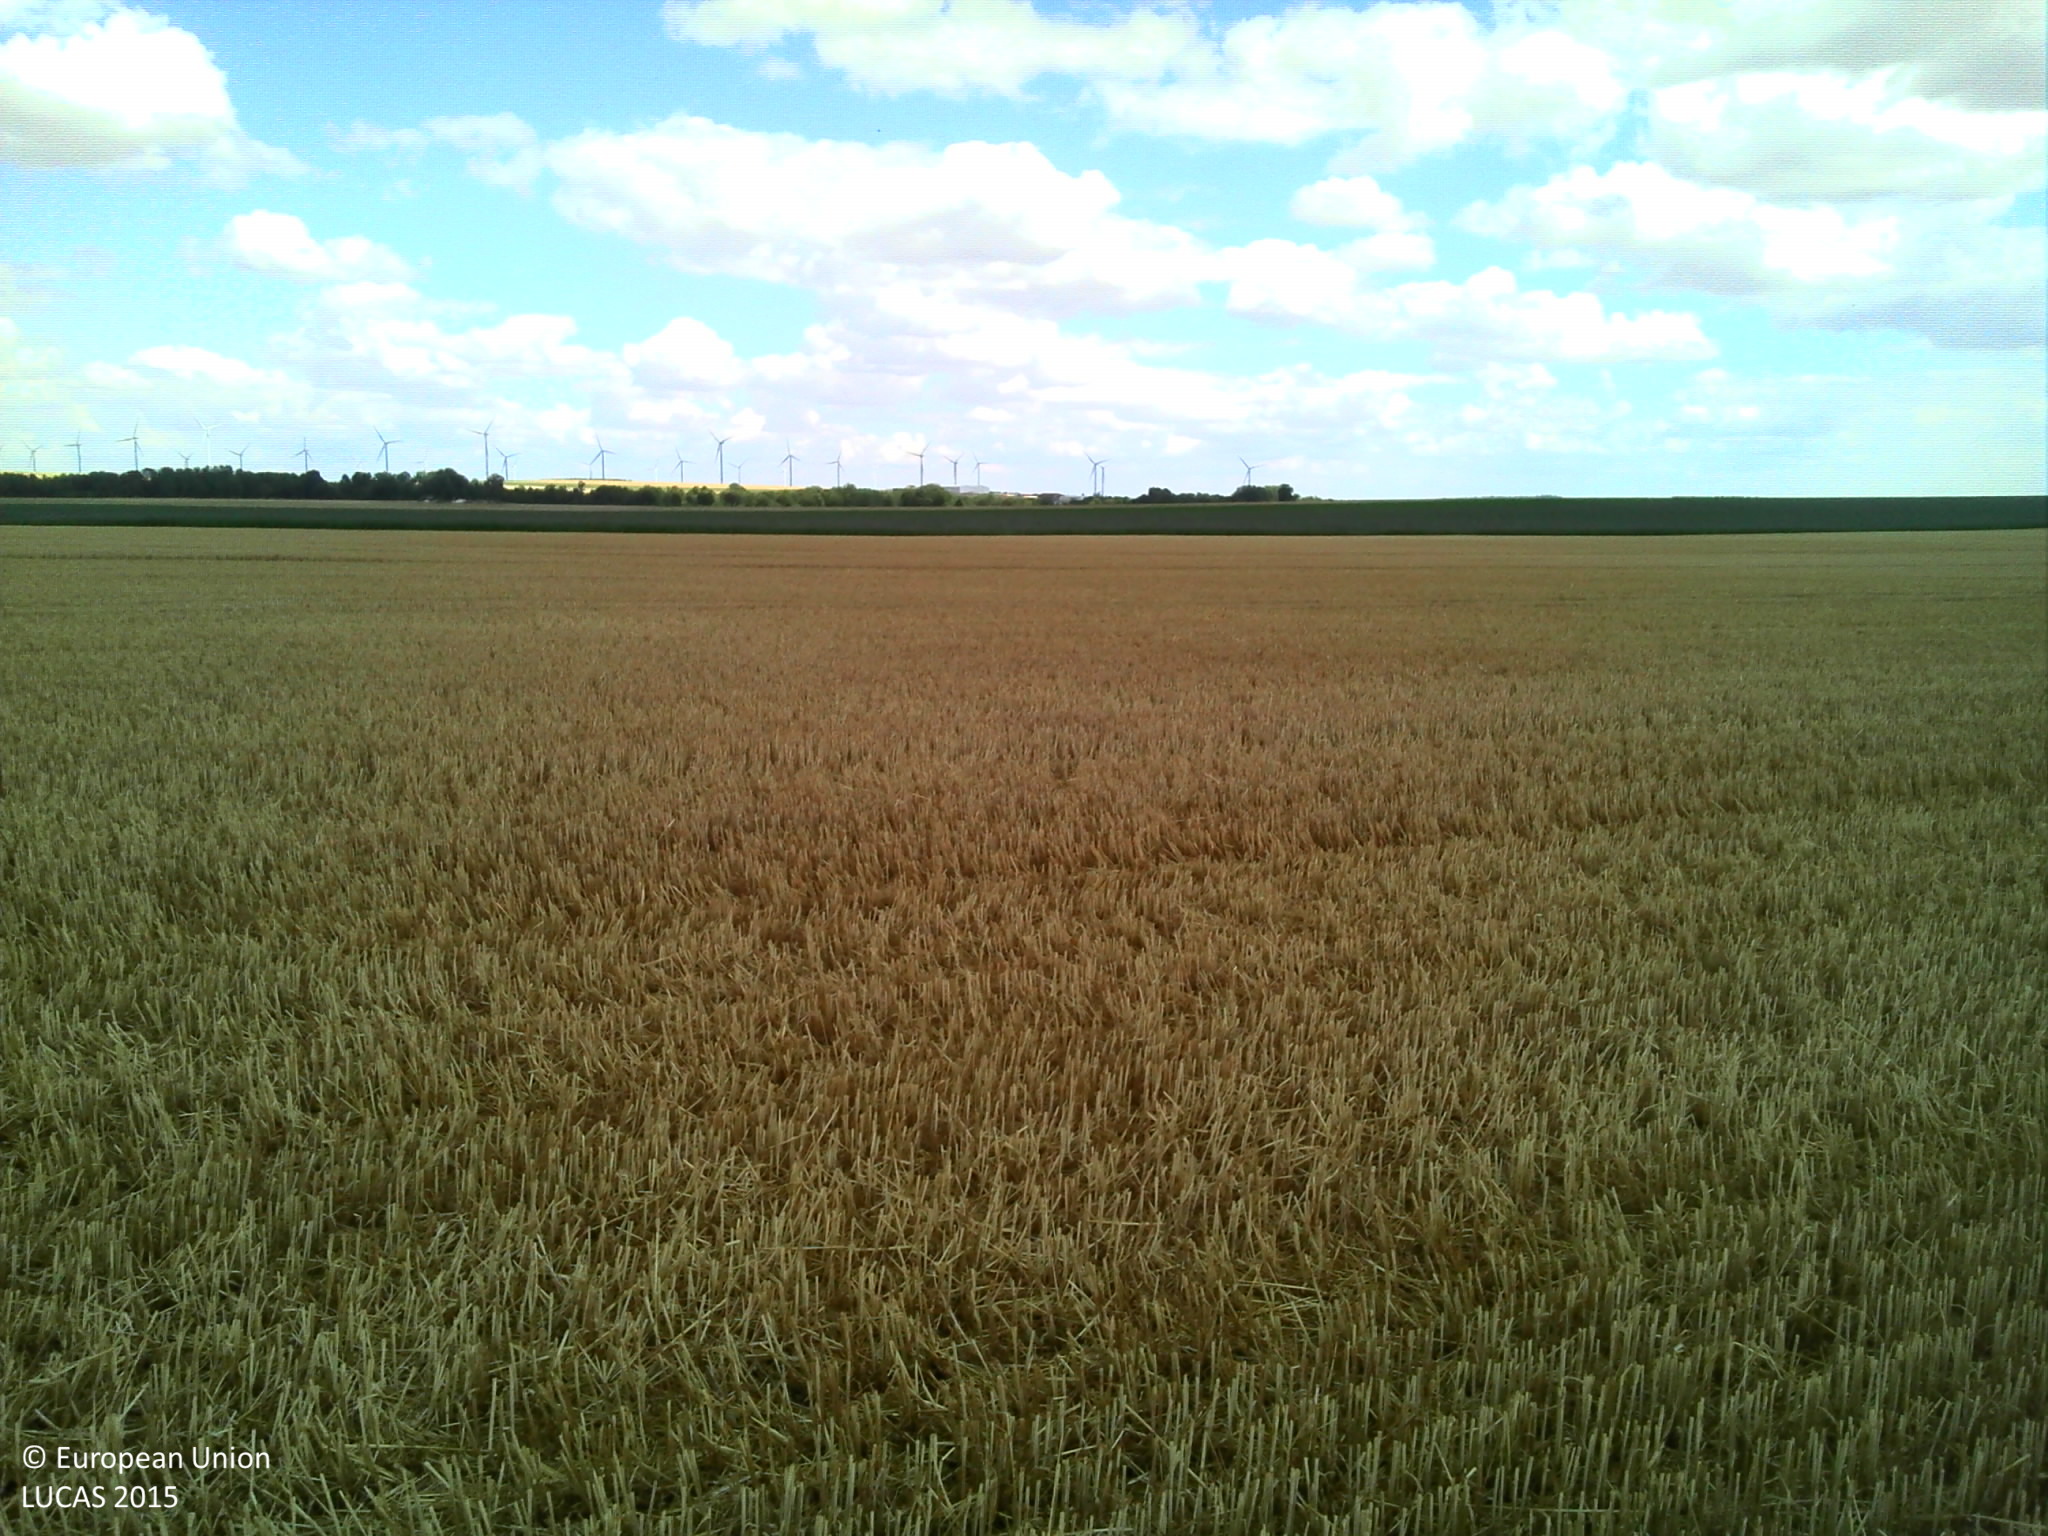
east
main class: Cropland
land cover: Common wheat
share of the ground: > 75 %
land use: Agriculture (excluding fallow land and kitchen gardens)
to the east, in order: Common wheat; Lucerne
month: July
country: FR
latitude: 48.8783
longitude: 4.1187
